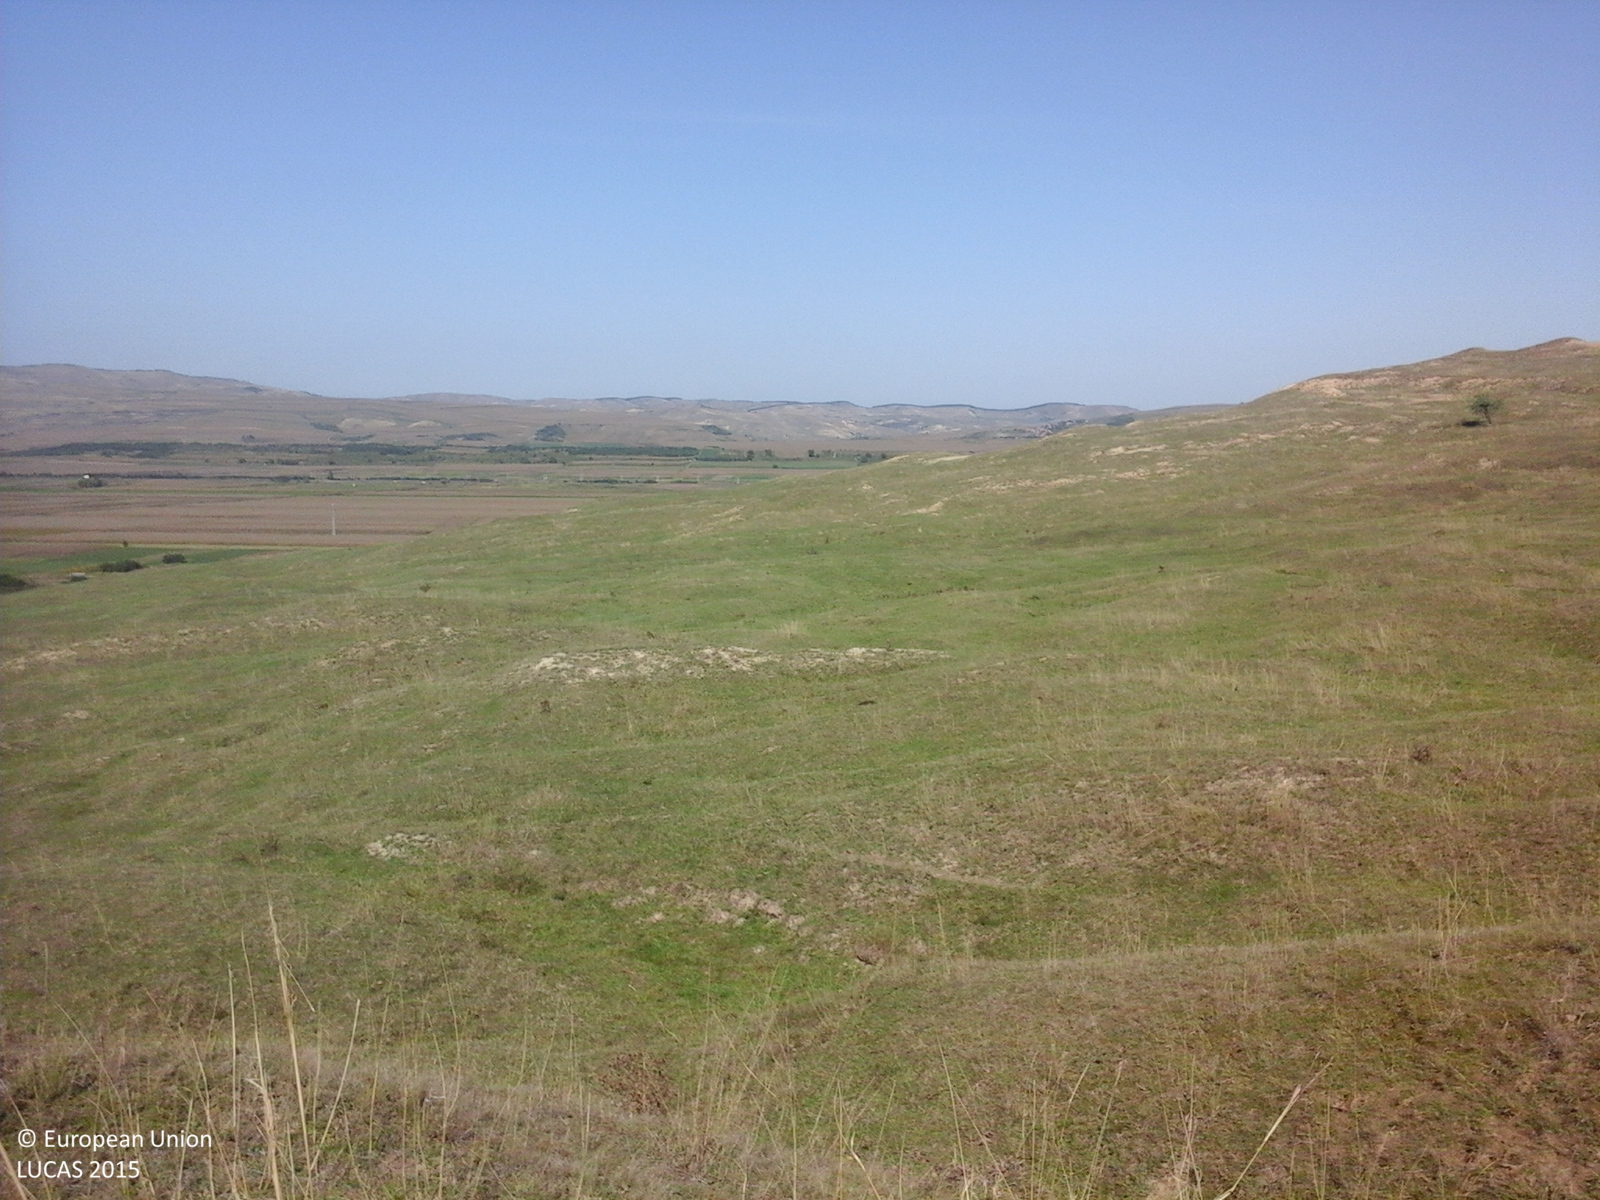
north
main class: Grassland
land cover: Grassland without tree/shrub cover
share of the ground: > 75 %
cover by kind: herbaceous plants 100 %
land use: Agriculture (excluding fallow land and kitchen gardens)
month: October
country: RO
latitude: 46.1623
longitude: 23.8114
